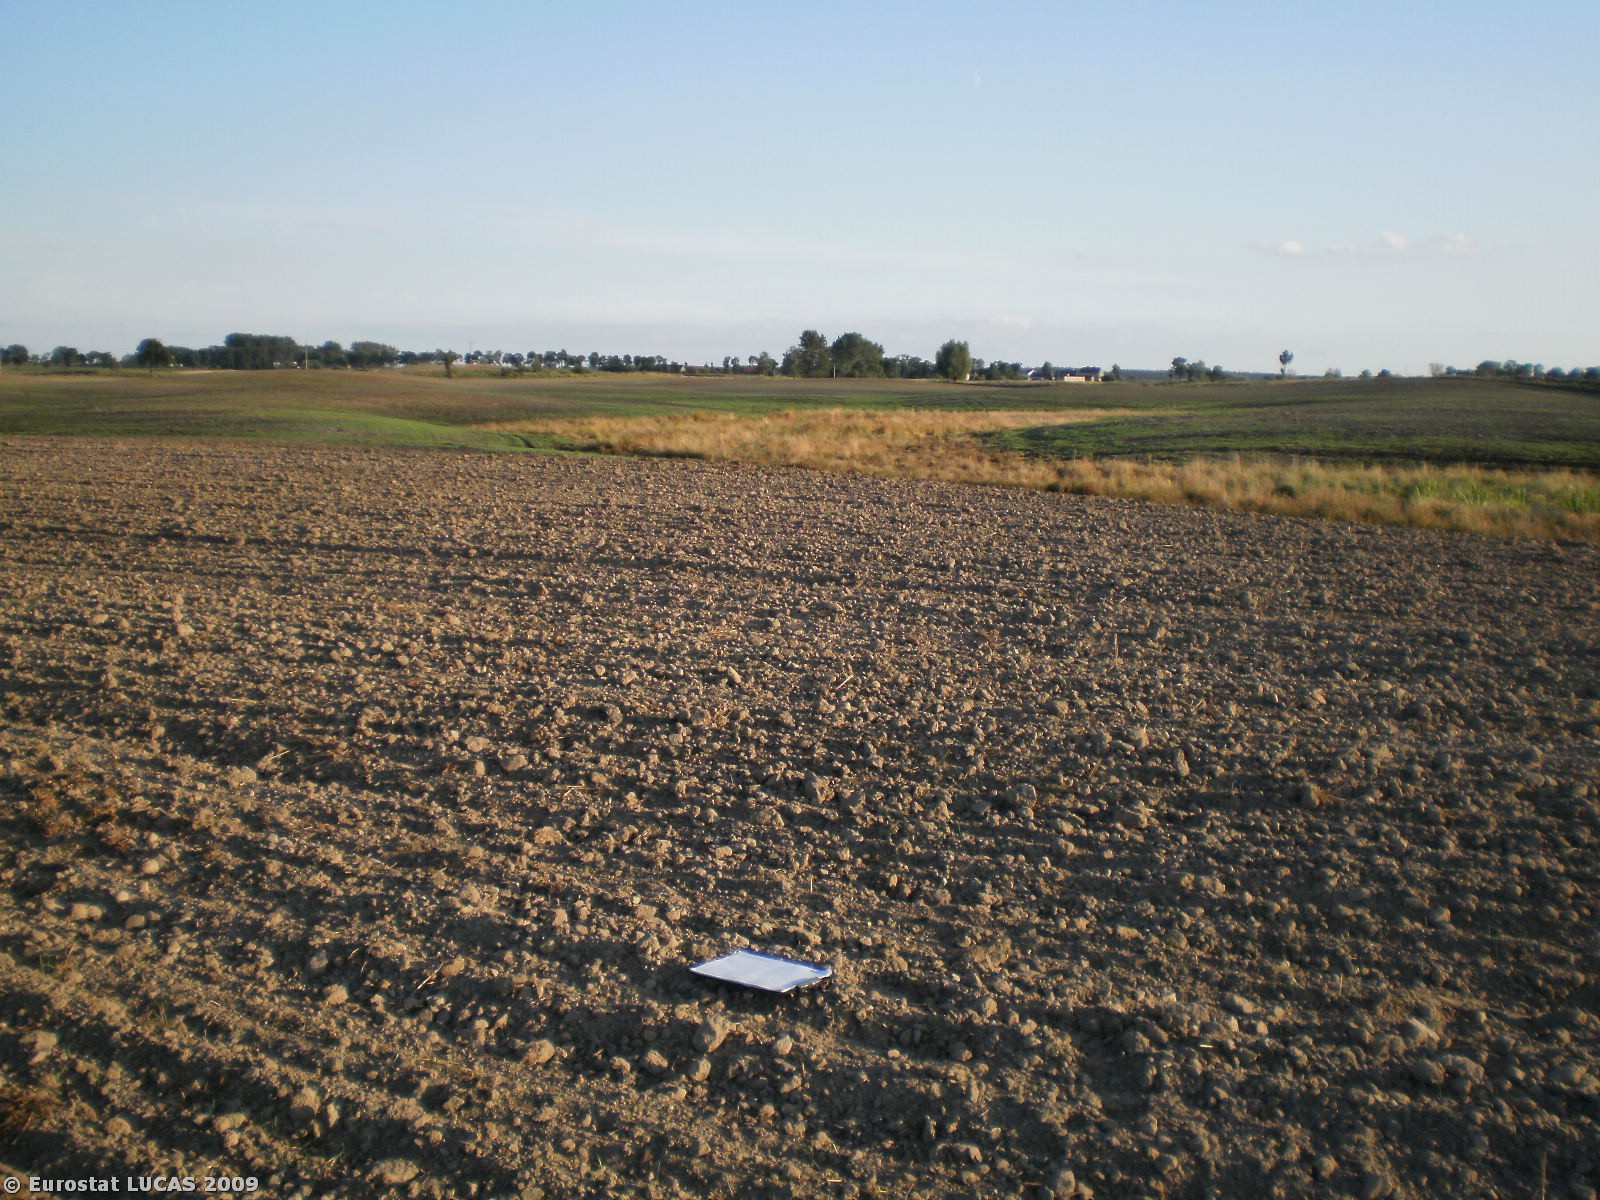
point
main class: Cropland
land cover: Triticale
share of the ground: < 10 %
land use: Agriculture (excluding fallow land and kitchen gardens)
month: August
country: PL
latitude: 53.8698
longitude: 21.6865
